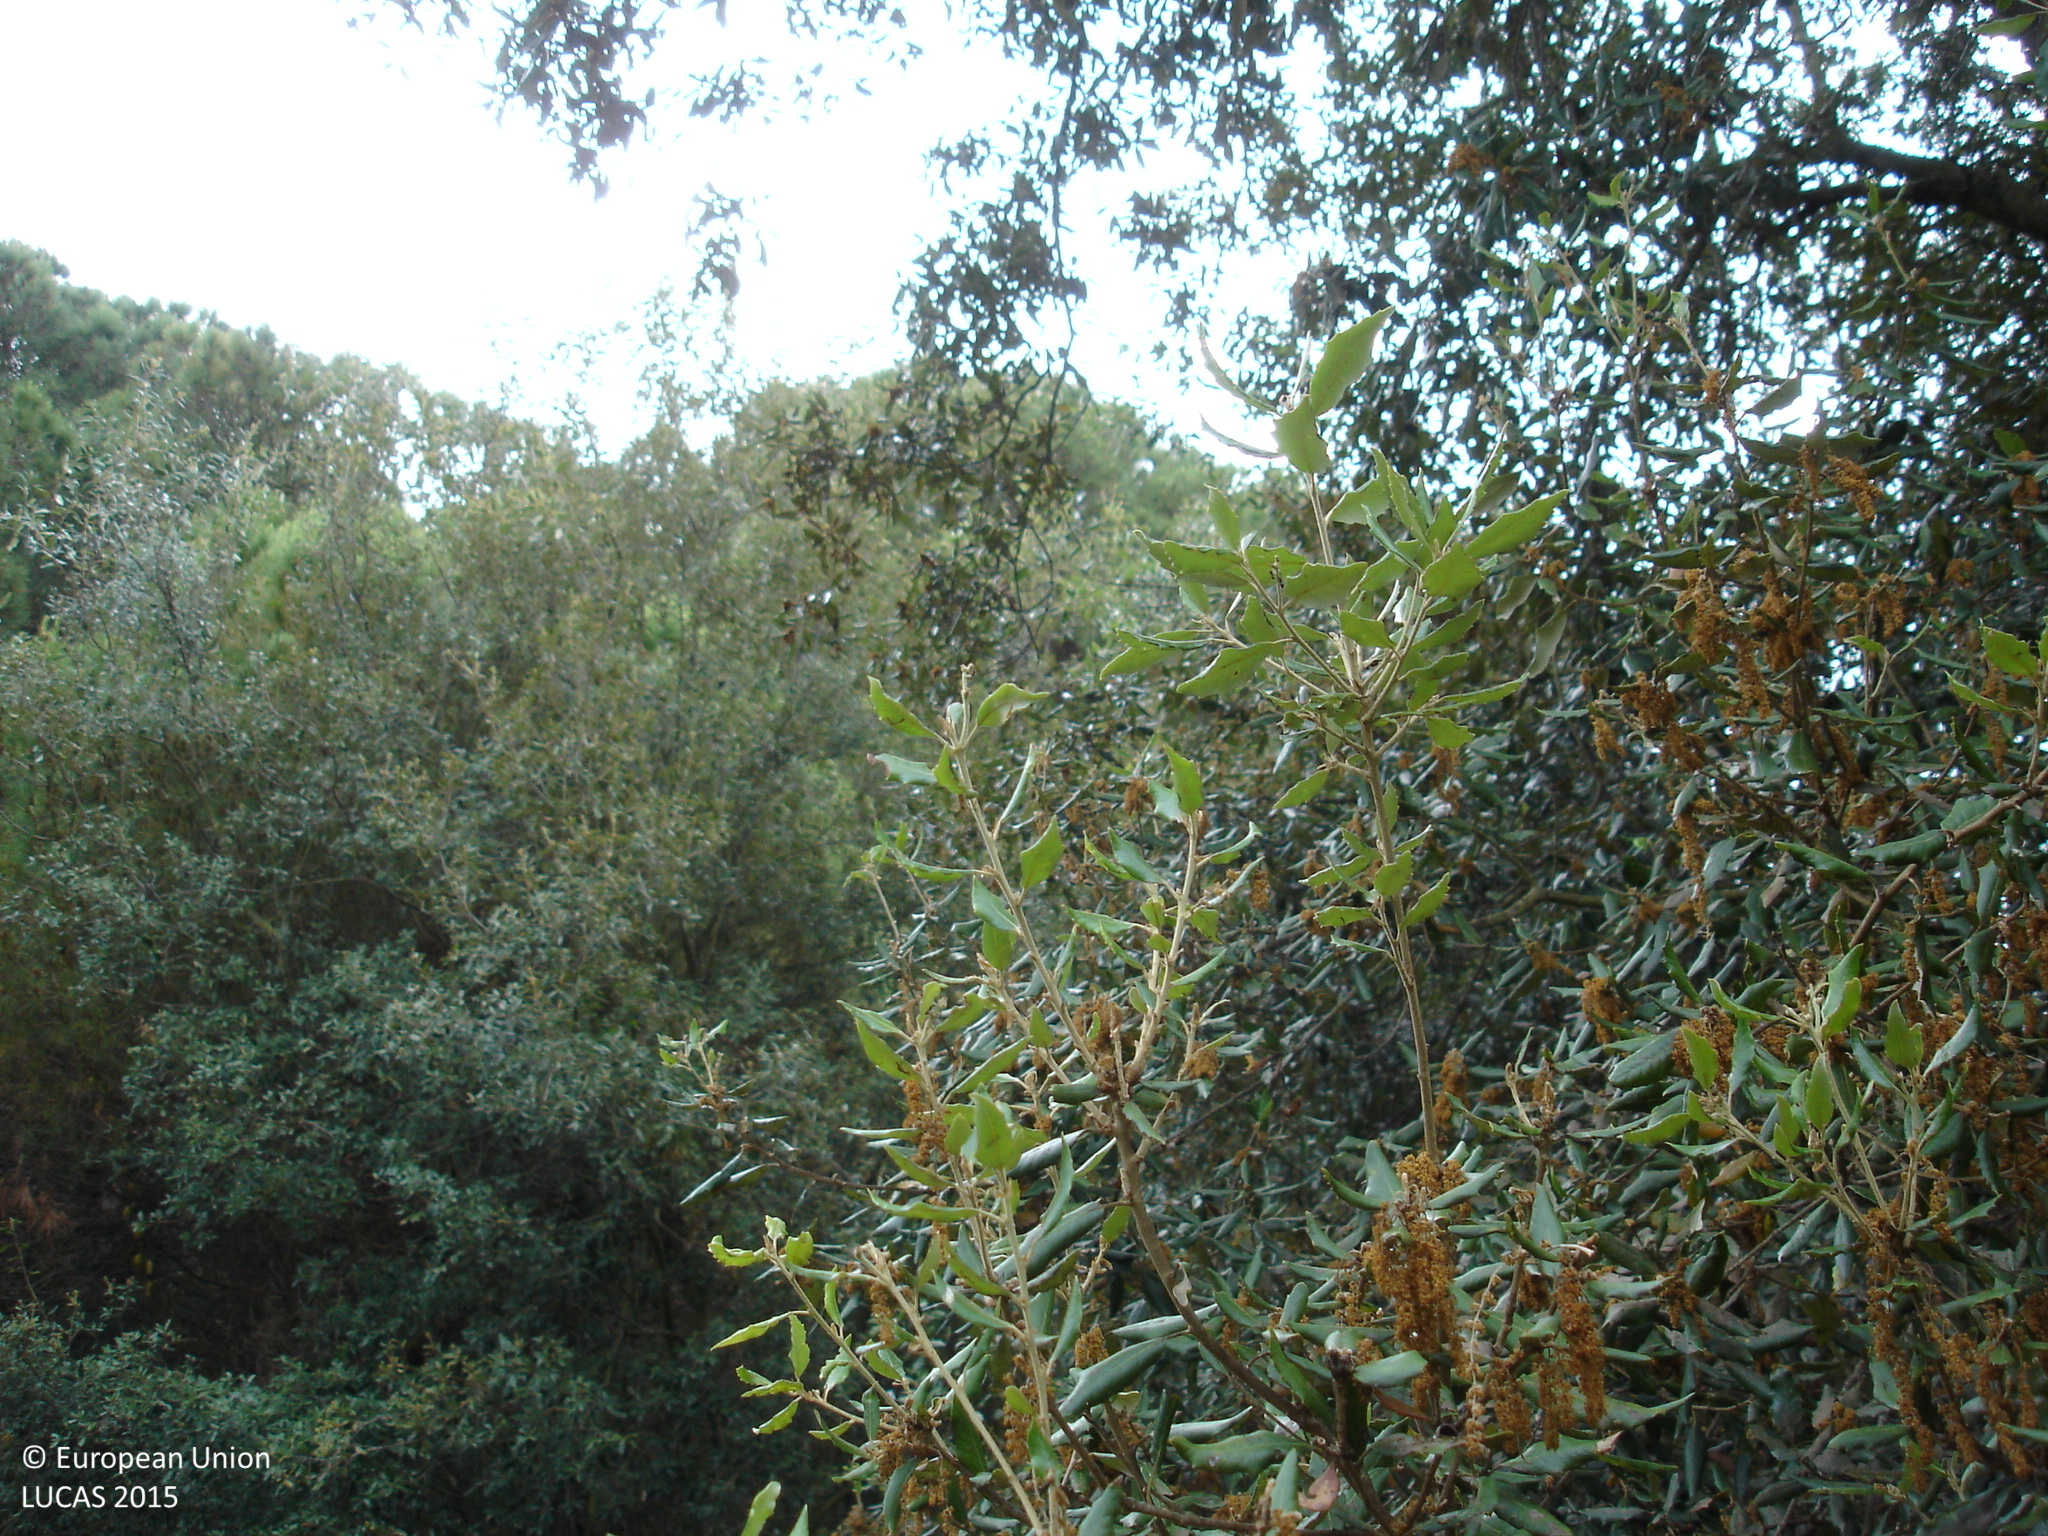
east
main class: Grassland
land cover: Grassland with sparse tree/shrub cover
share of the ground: > 75 %
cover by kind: herbaceous plants 90 %, broadleaved forest trees 5 %, shrubs 5 %
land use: Semi-natural and natural areas not in use
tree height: > 5 m
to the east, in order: Grassland with sparse tree/shrub cover; Grassland without tree/shrub cover; Grassland with sparse tree/shrub cover; Tracks; Pine dominated mixed woodland; Pine dominated coniferous woodland; Tracks; Pine dominated coniferous woodland; Pine dominated mixed woodland; Tracks; Pine dominated mixed woodland
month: June
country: ES
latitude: 41.6043
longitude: 2.6142
